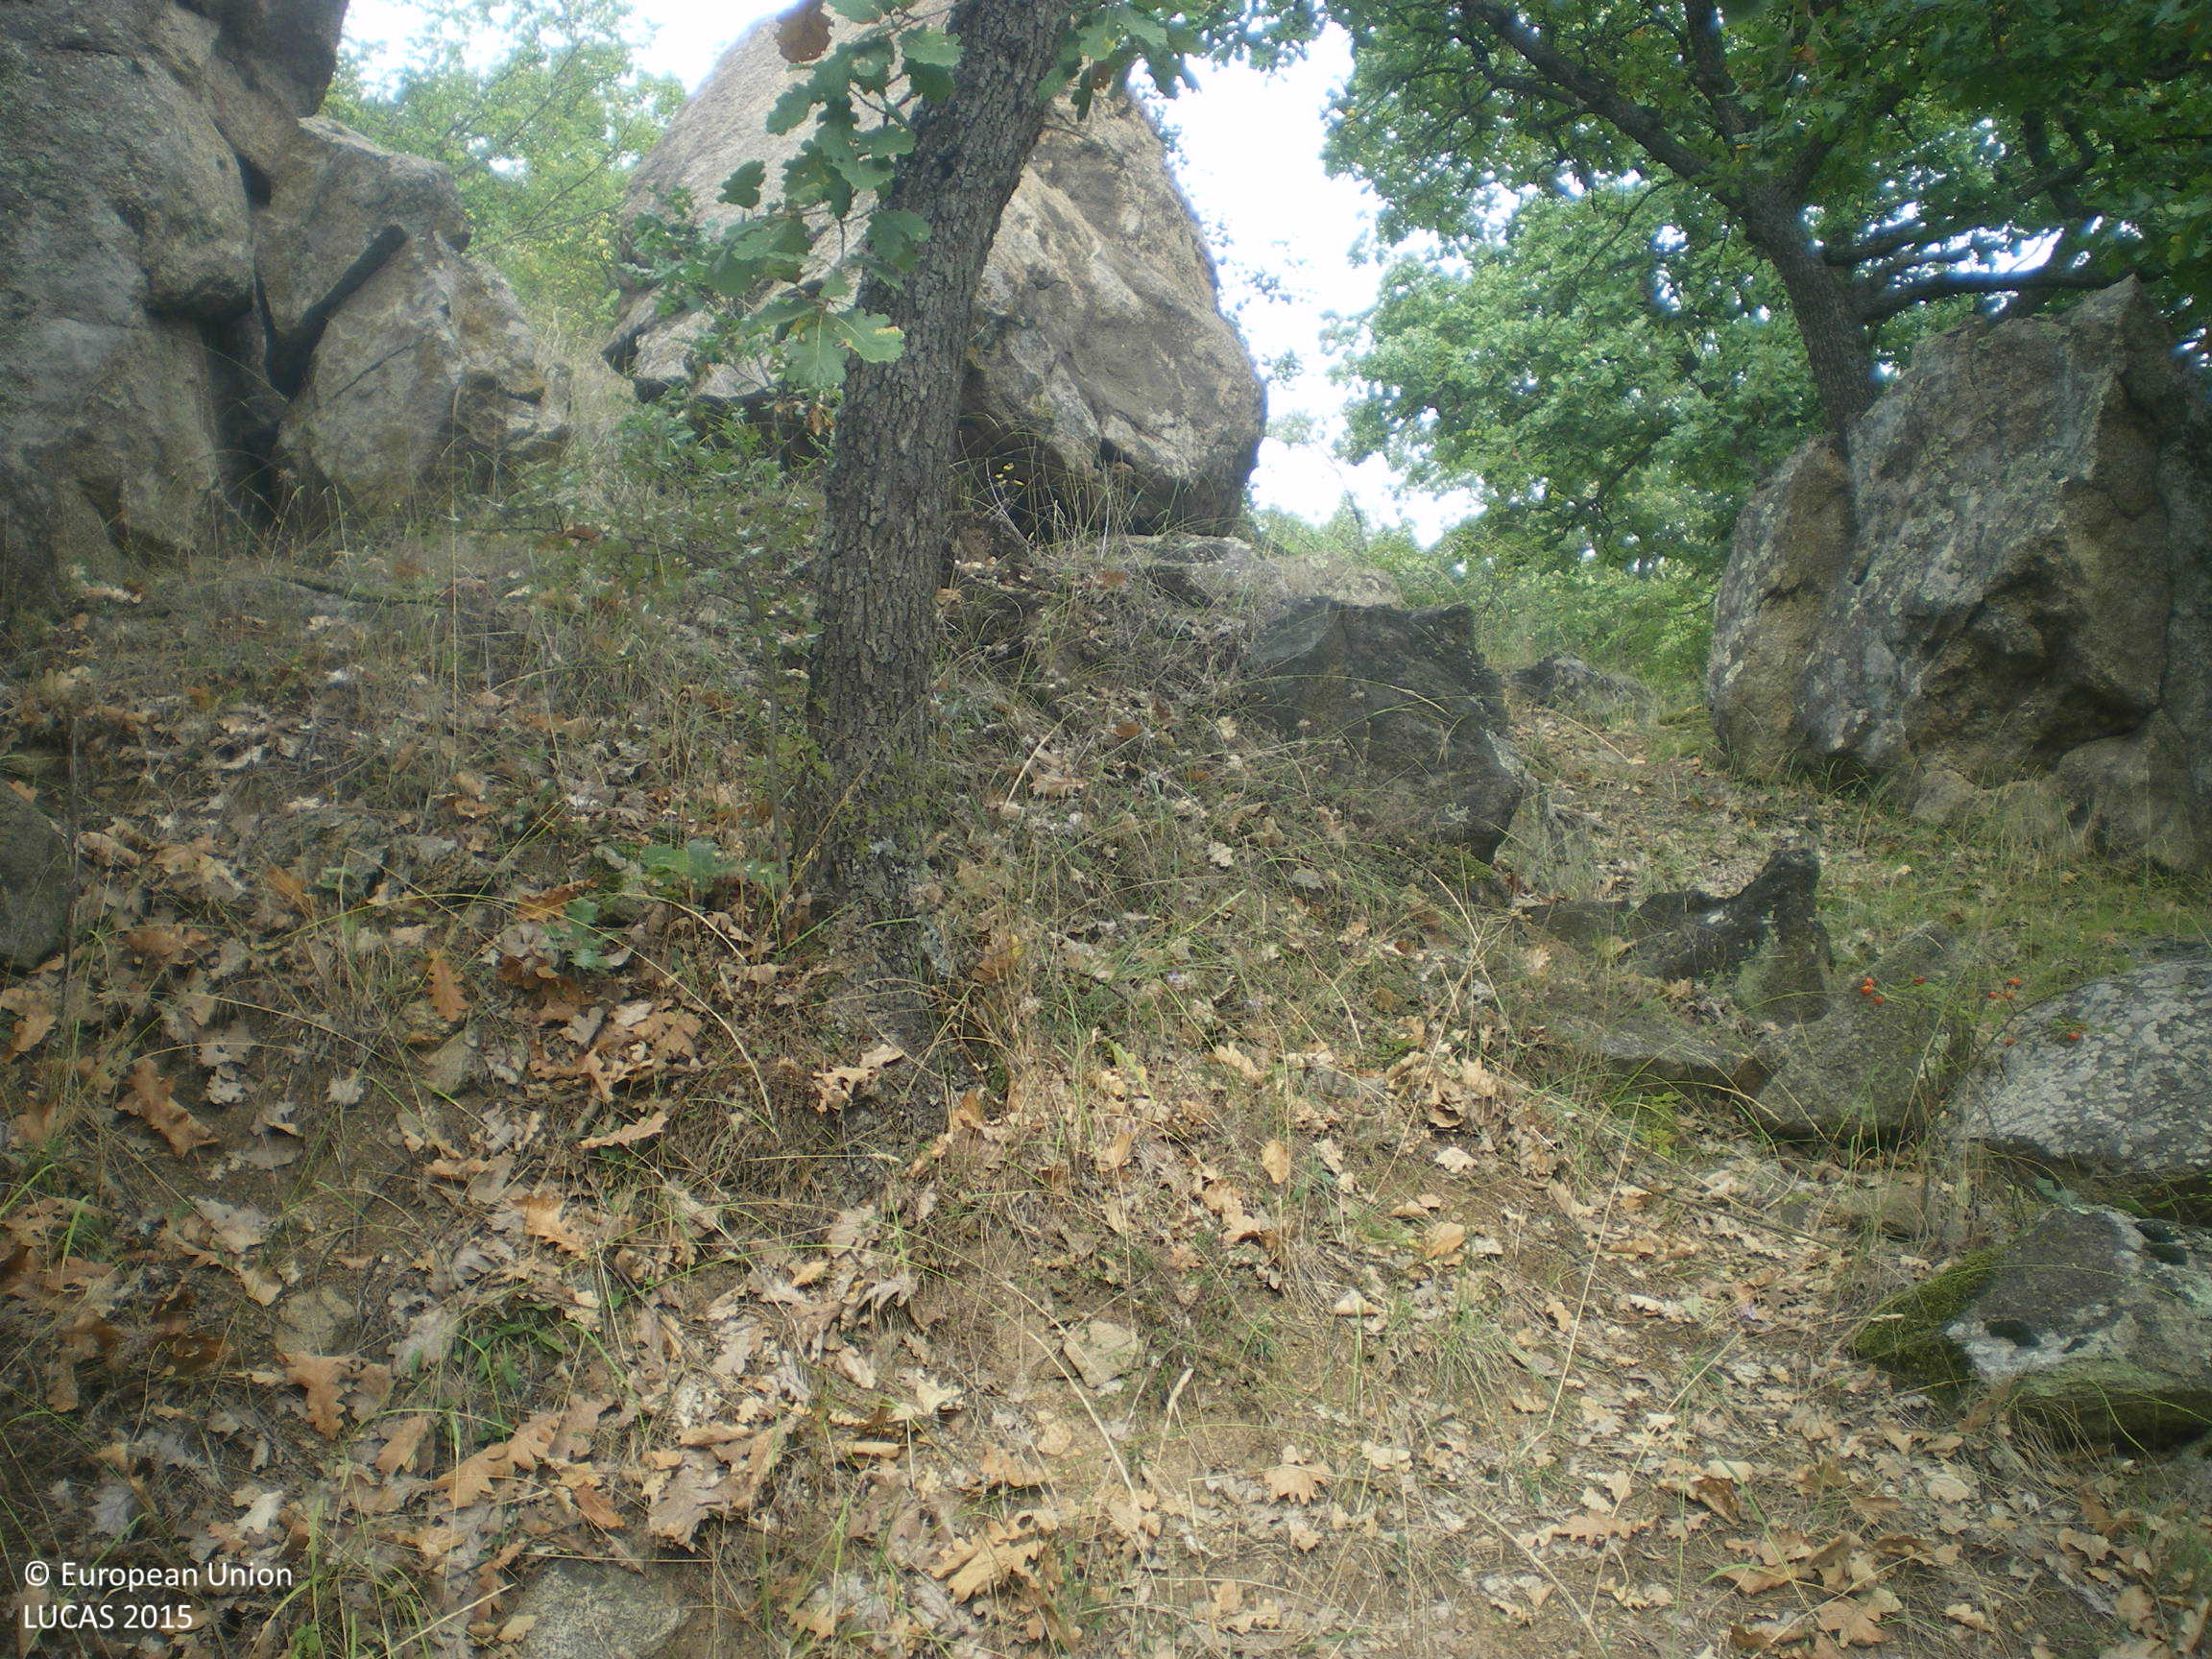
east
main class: Woodland
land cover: Broadleaved woodland
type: mesophytic deciduous forest
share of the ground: > 75 %
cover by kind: broadleaved forest trees 60 %, unconsolidated bare surface 20 %, shrubs 10 %, herbaceous plants 10 %
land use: Forestry
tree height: > 5 m
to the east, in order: Broadleaved woodland; Rocks and stones; Broadleaved woodland; Tracks; Broadleaved woodland; Rivers and streams; Broadleaved woodland; Rivers and streams; Broadleaved woodland
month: September
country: BG
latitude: 41.8681
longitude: 25.8893
